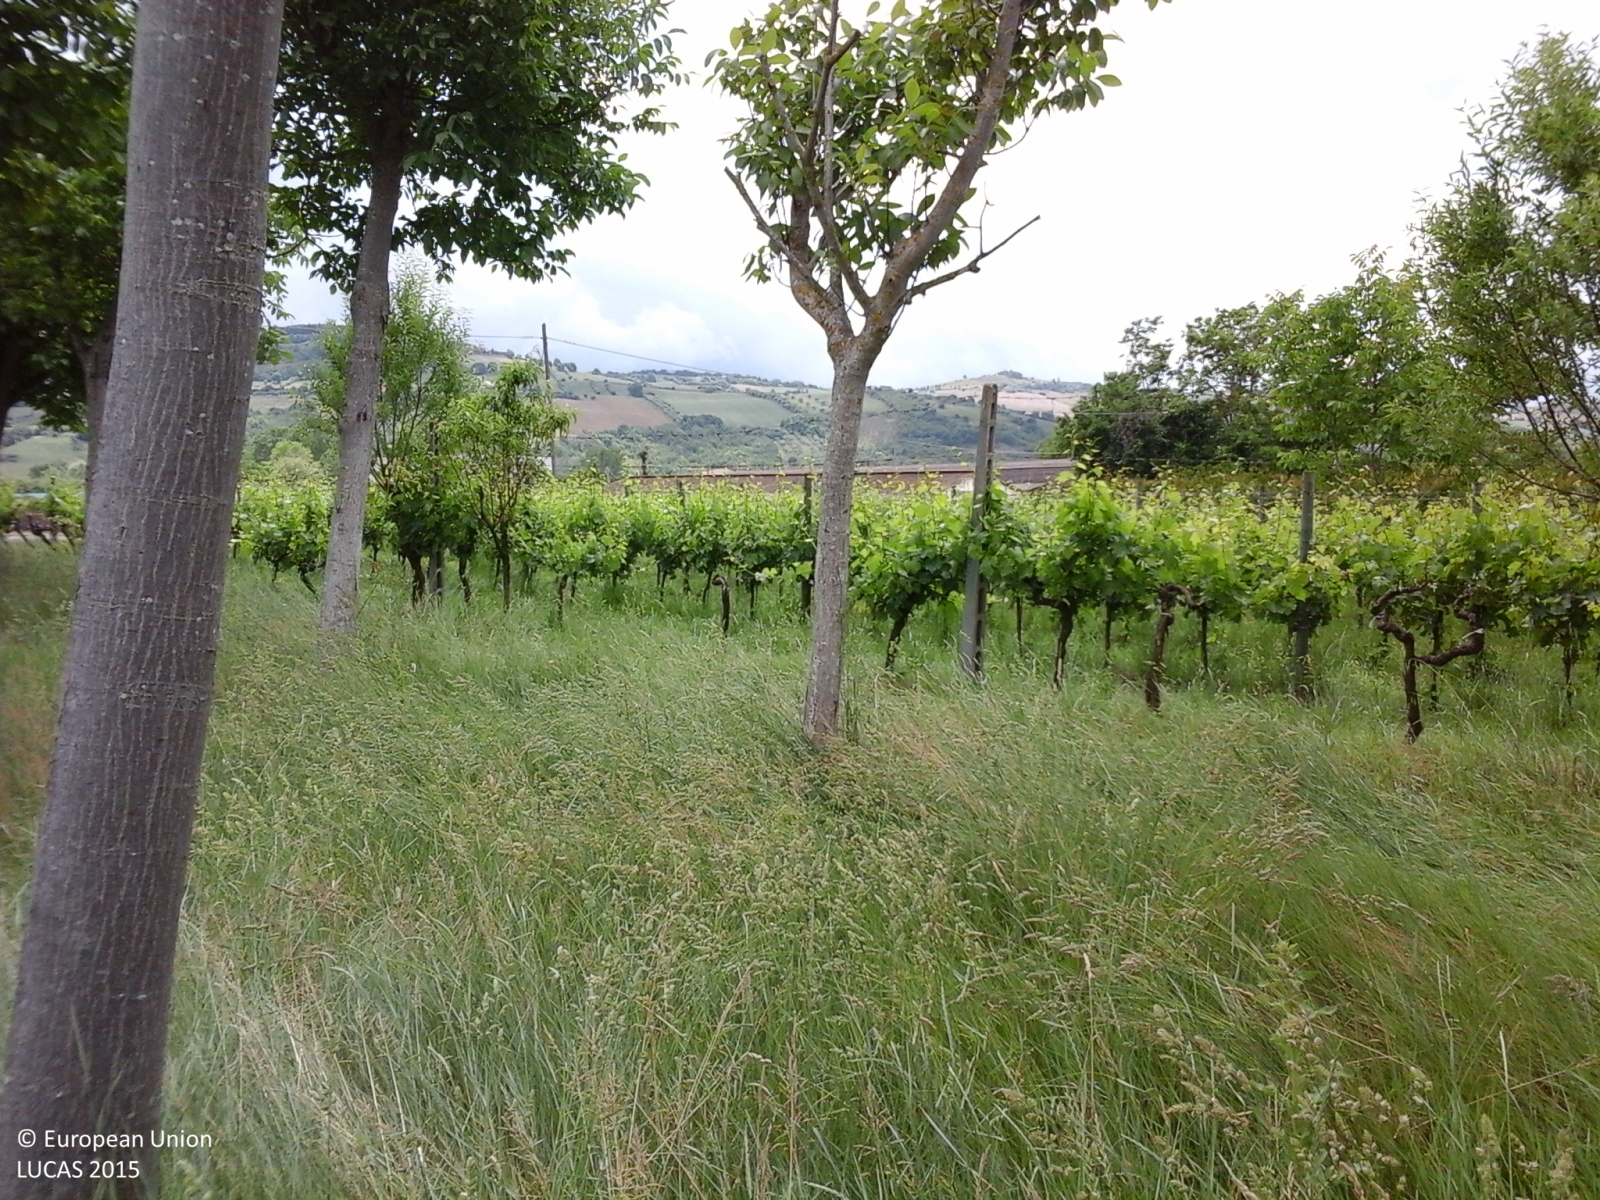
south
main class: Cropland
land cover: Nuts trees
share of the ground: > 75 %
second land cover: Grassland without tree/shrub cover
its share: > 75 %
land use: Agriculture (excluding fallow land and kitchen gardens)
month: May
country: IT
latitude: 42.8721
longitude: 13.7966
